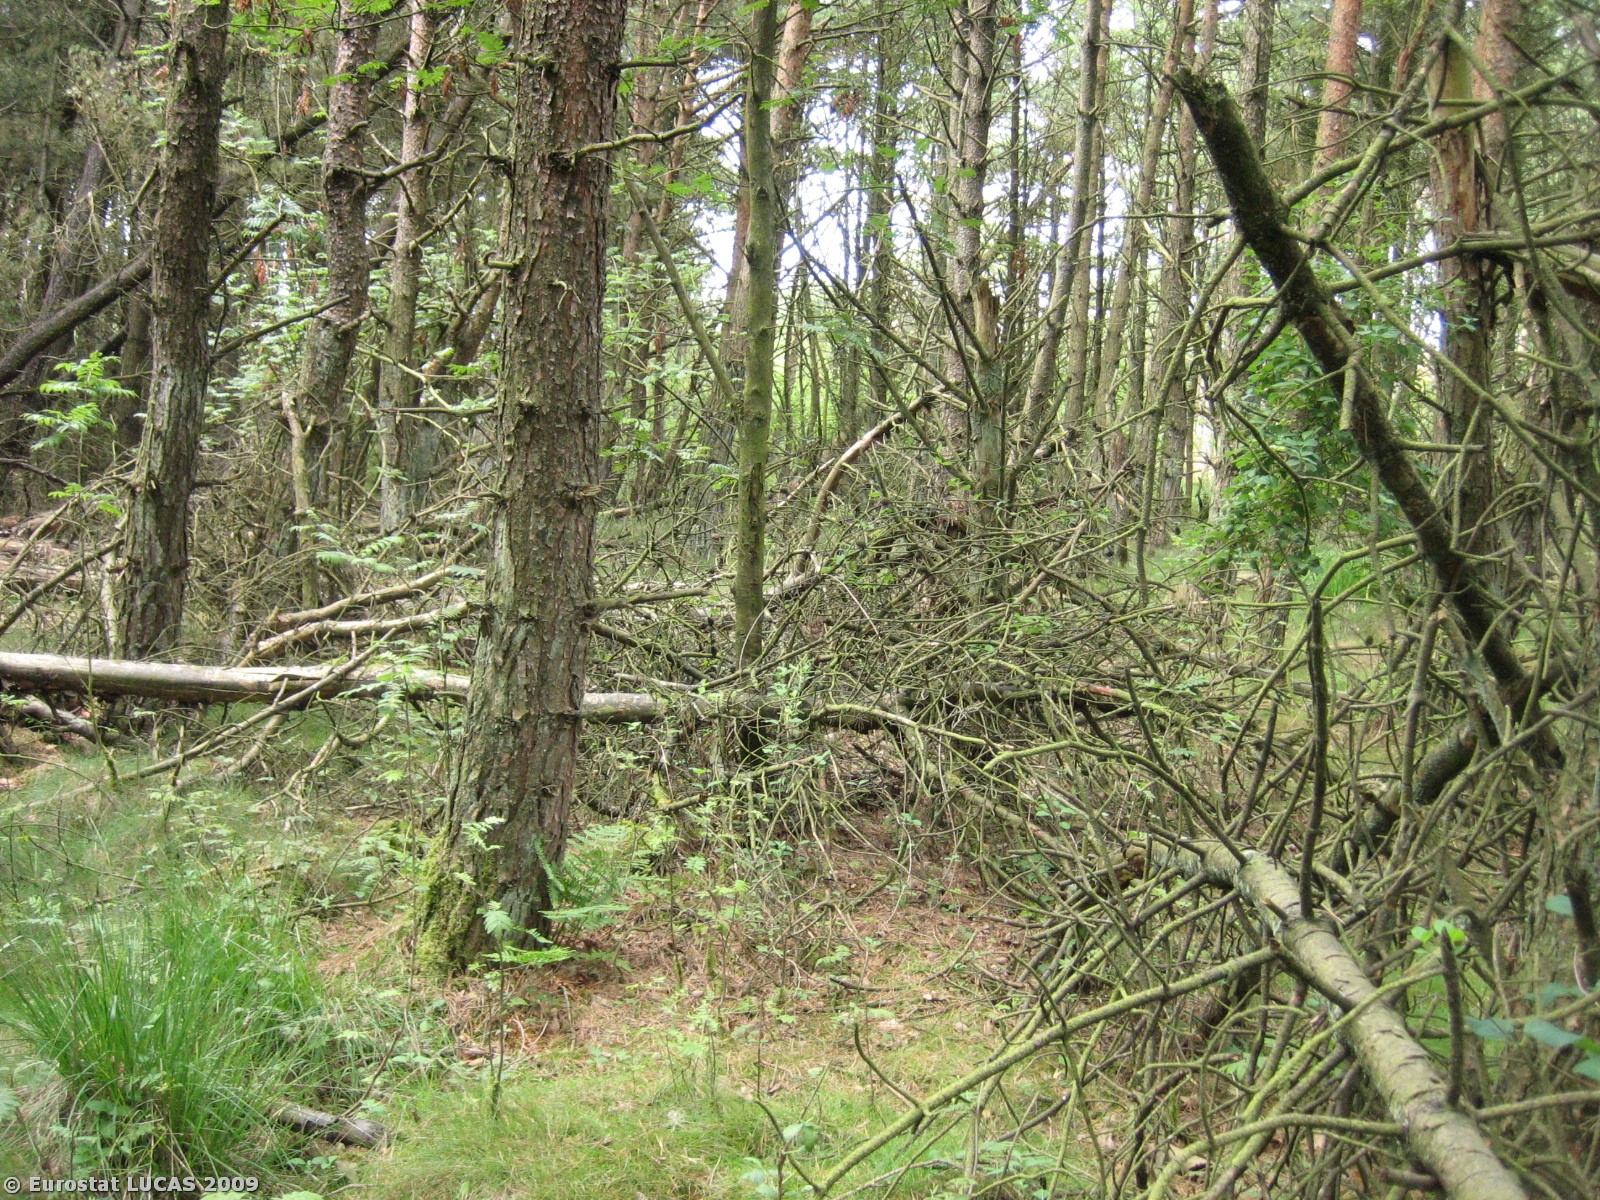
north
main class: Woodland
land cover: Coniferous woodland
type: hemiboreal forest and nemoral coniferous forest and mixed broadleaved-coniferous forest
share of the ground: > 75 %
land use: Forestry
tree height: > 5 m
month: July
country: DK
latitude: 55.7261
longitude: 8.2343
